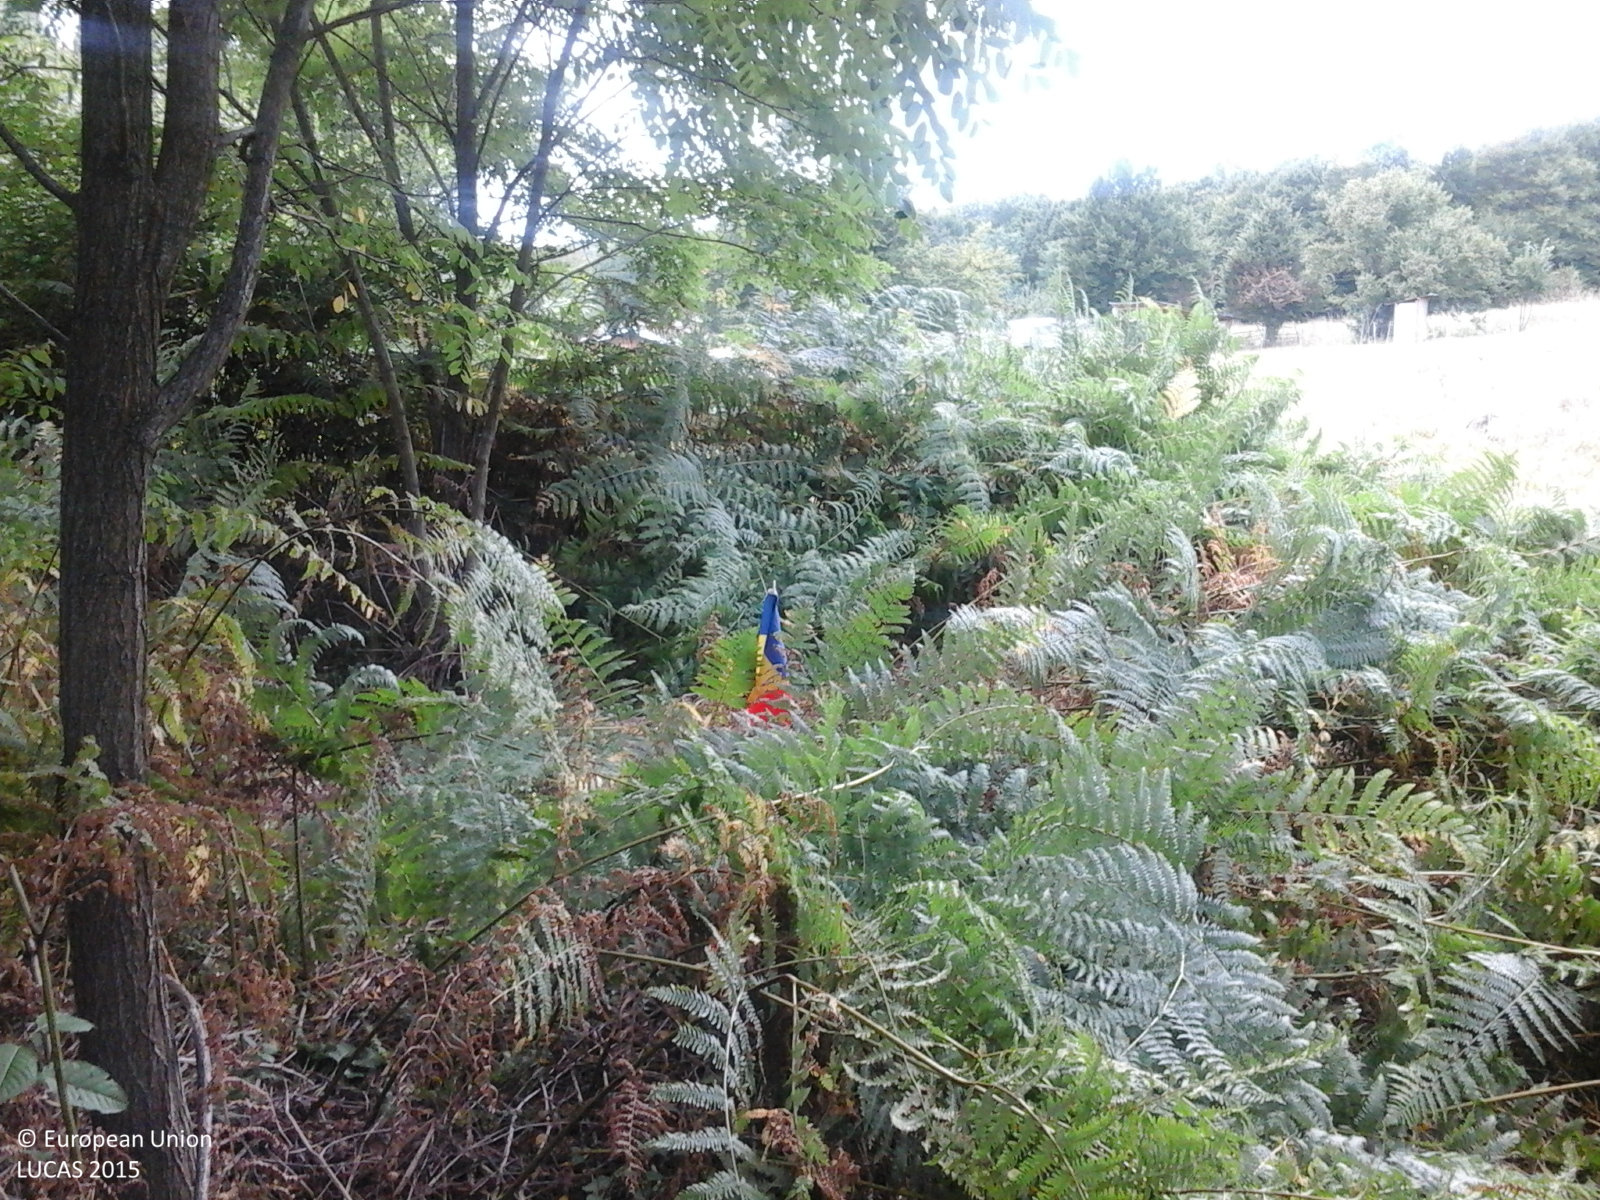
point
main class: Woodland
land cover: Broadleaved woodland
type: broadleaved evergreen forest
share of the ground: > 75 %
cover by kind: broadleaved forest trees 100 %
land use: Forestry
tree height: > 5 m
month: August
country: RO
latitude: 45.2065
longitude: 21.9400
